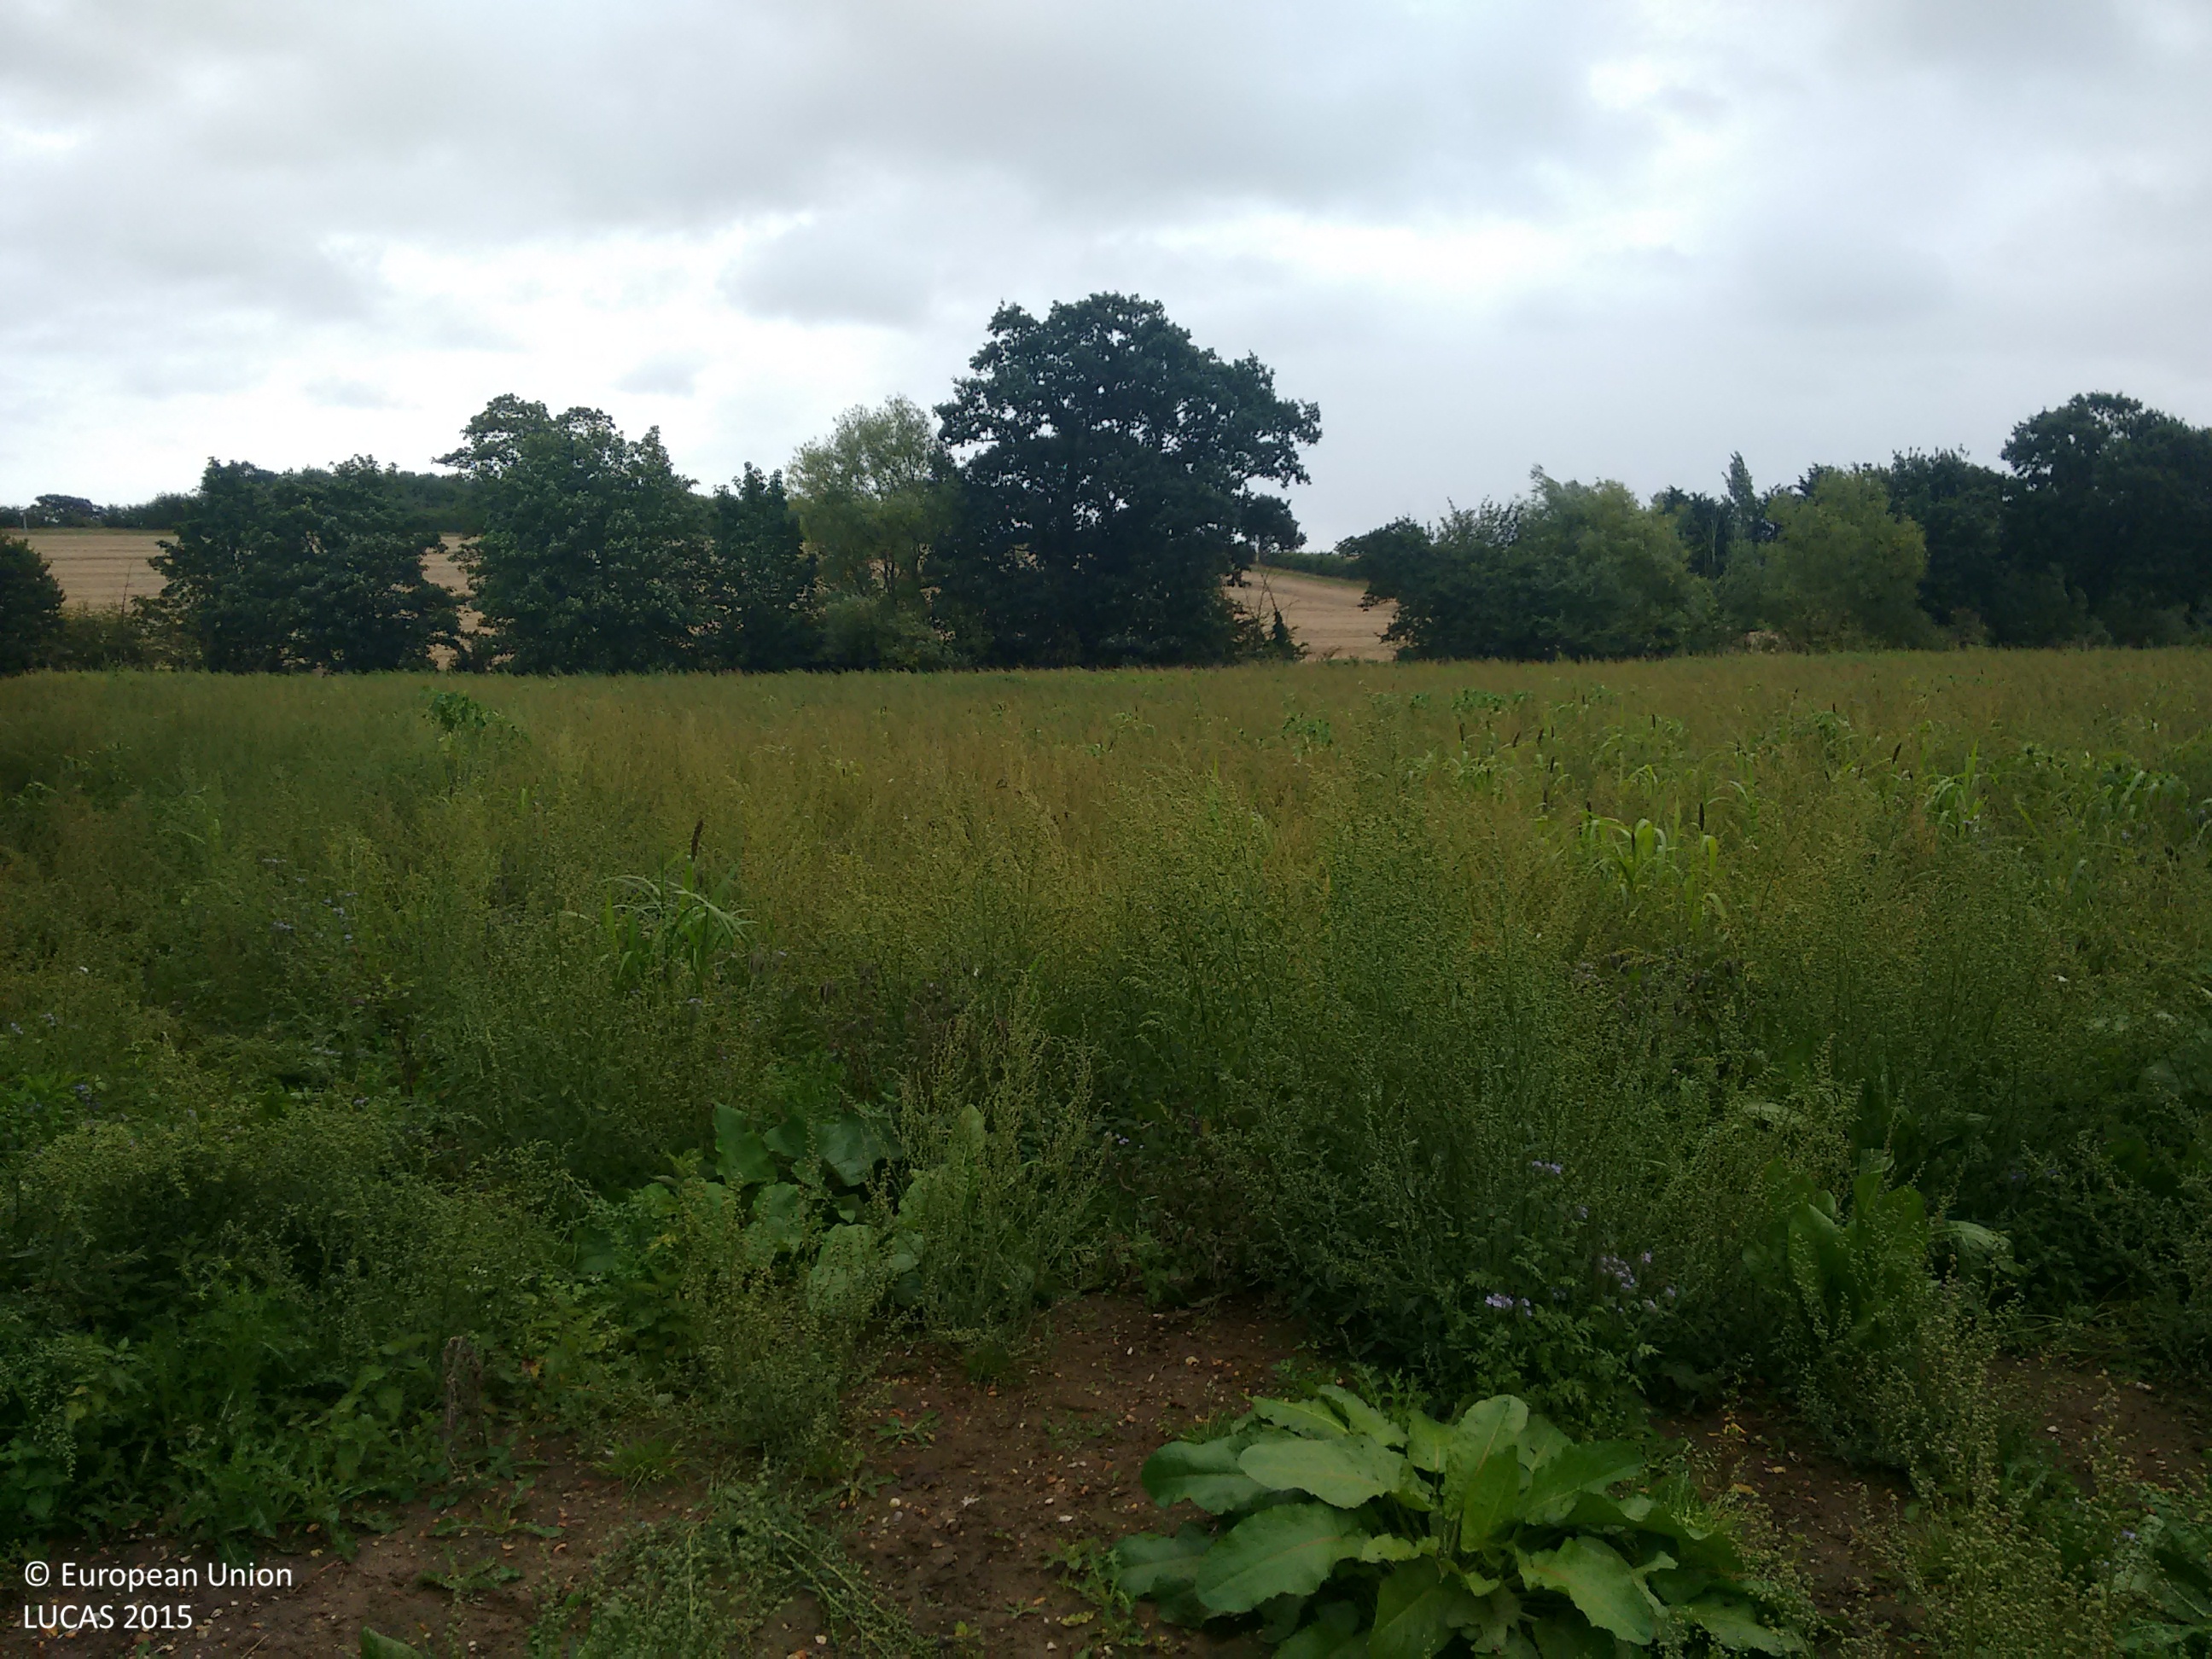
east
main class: Woodland
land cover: Broadleaved woodland
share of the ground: > 75 %
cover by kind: broadleaved forest trees 80 %, shrubs 20 %
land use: Agriculture (excluding fallow land and kitchen gardens)
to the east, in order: Broadleaved woodland; Ditches and canals; Shrubland without tree cover; Grassland without tree/shrub cover; Shrubland without tree cover; Lines of trees; Inland fresh running water; Lines of trees; Shrubland without tree cover; Grassland without tree/shrub cover; Other bare soil
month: September
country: GB
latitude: 52.2602
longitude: 1.3502
